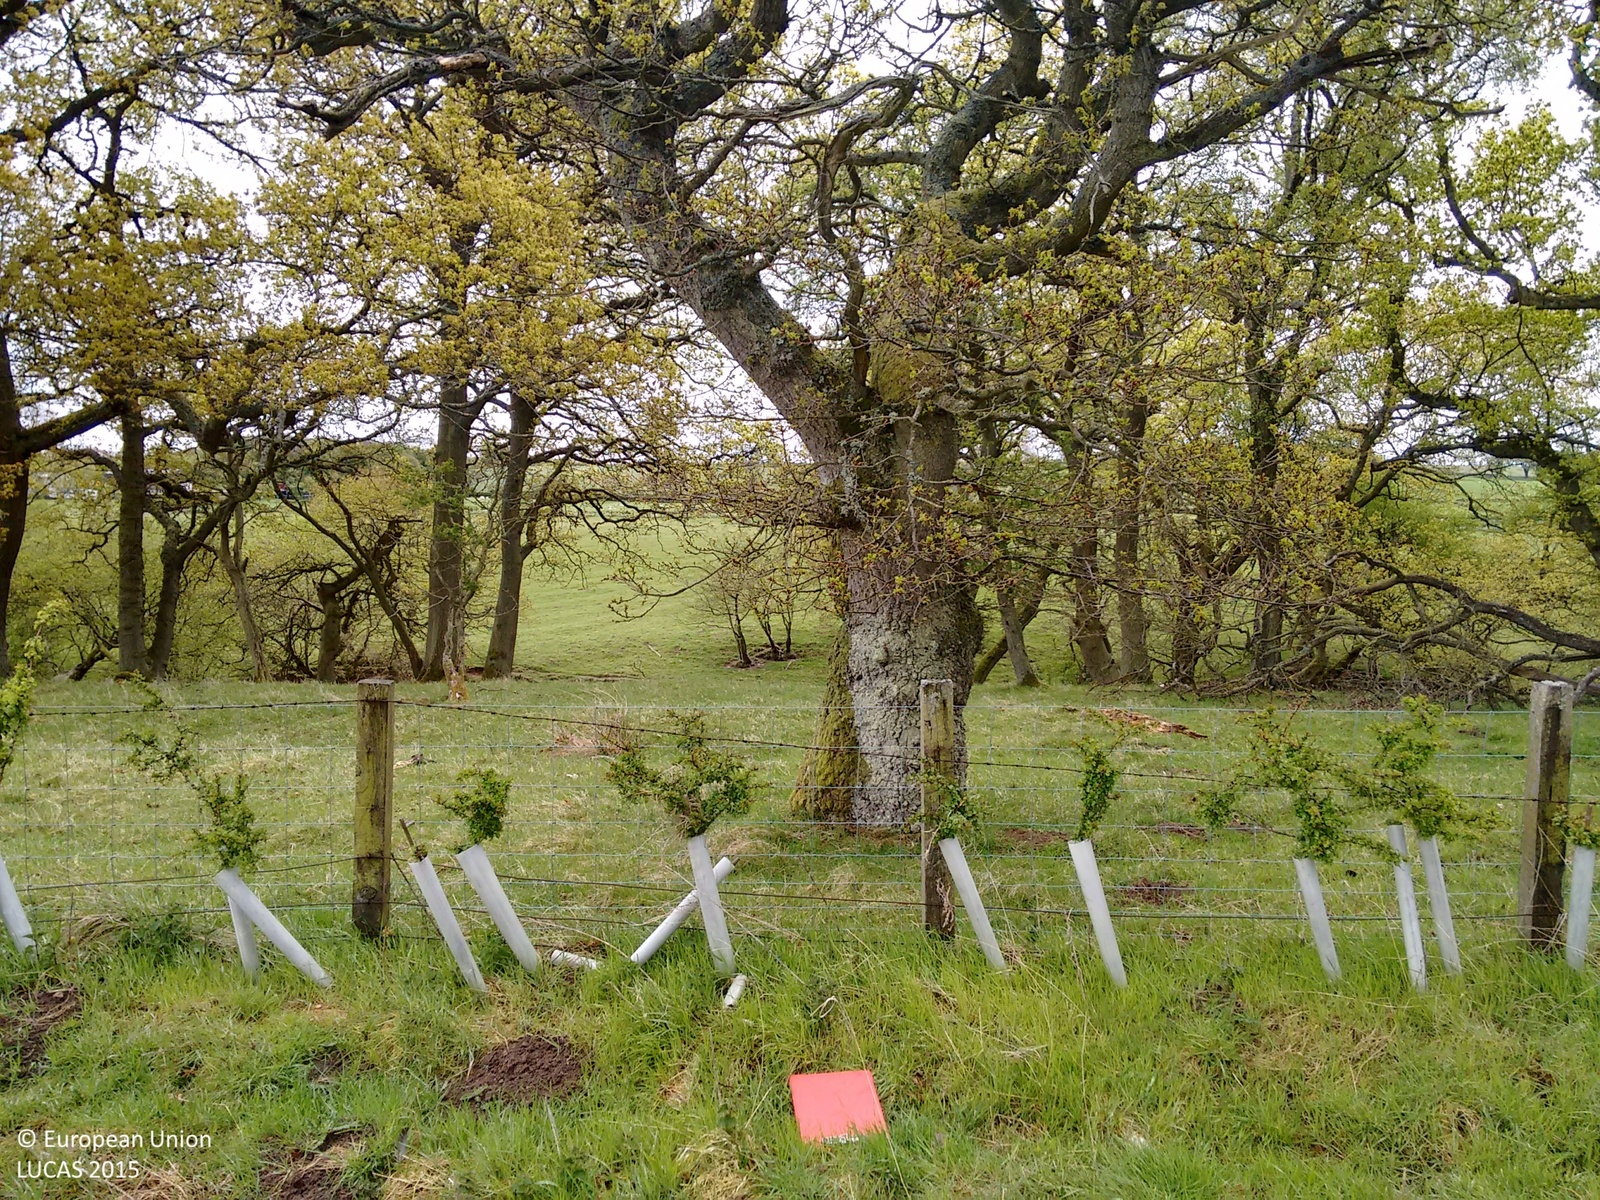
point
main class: Grassland
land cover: Grassland with sparse tree/shrub cover
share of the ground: > 75 %
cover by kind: herbaceous plants 95 %, broadleaved forest trees 5 %
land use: Agriculture (excluding fallow land and kitchen gardens)
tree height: > 5 m
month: May
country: GB
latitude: 55.3765
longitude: -1.7116
